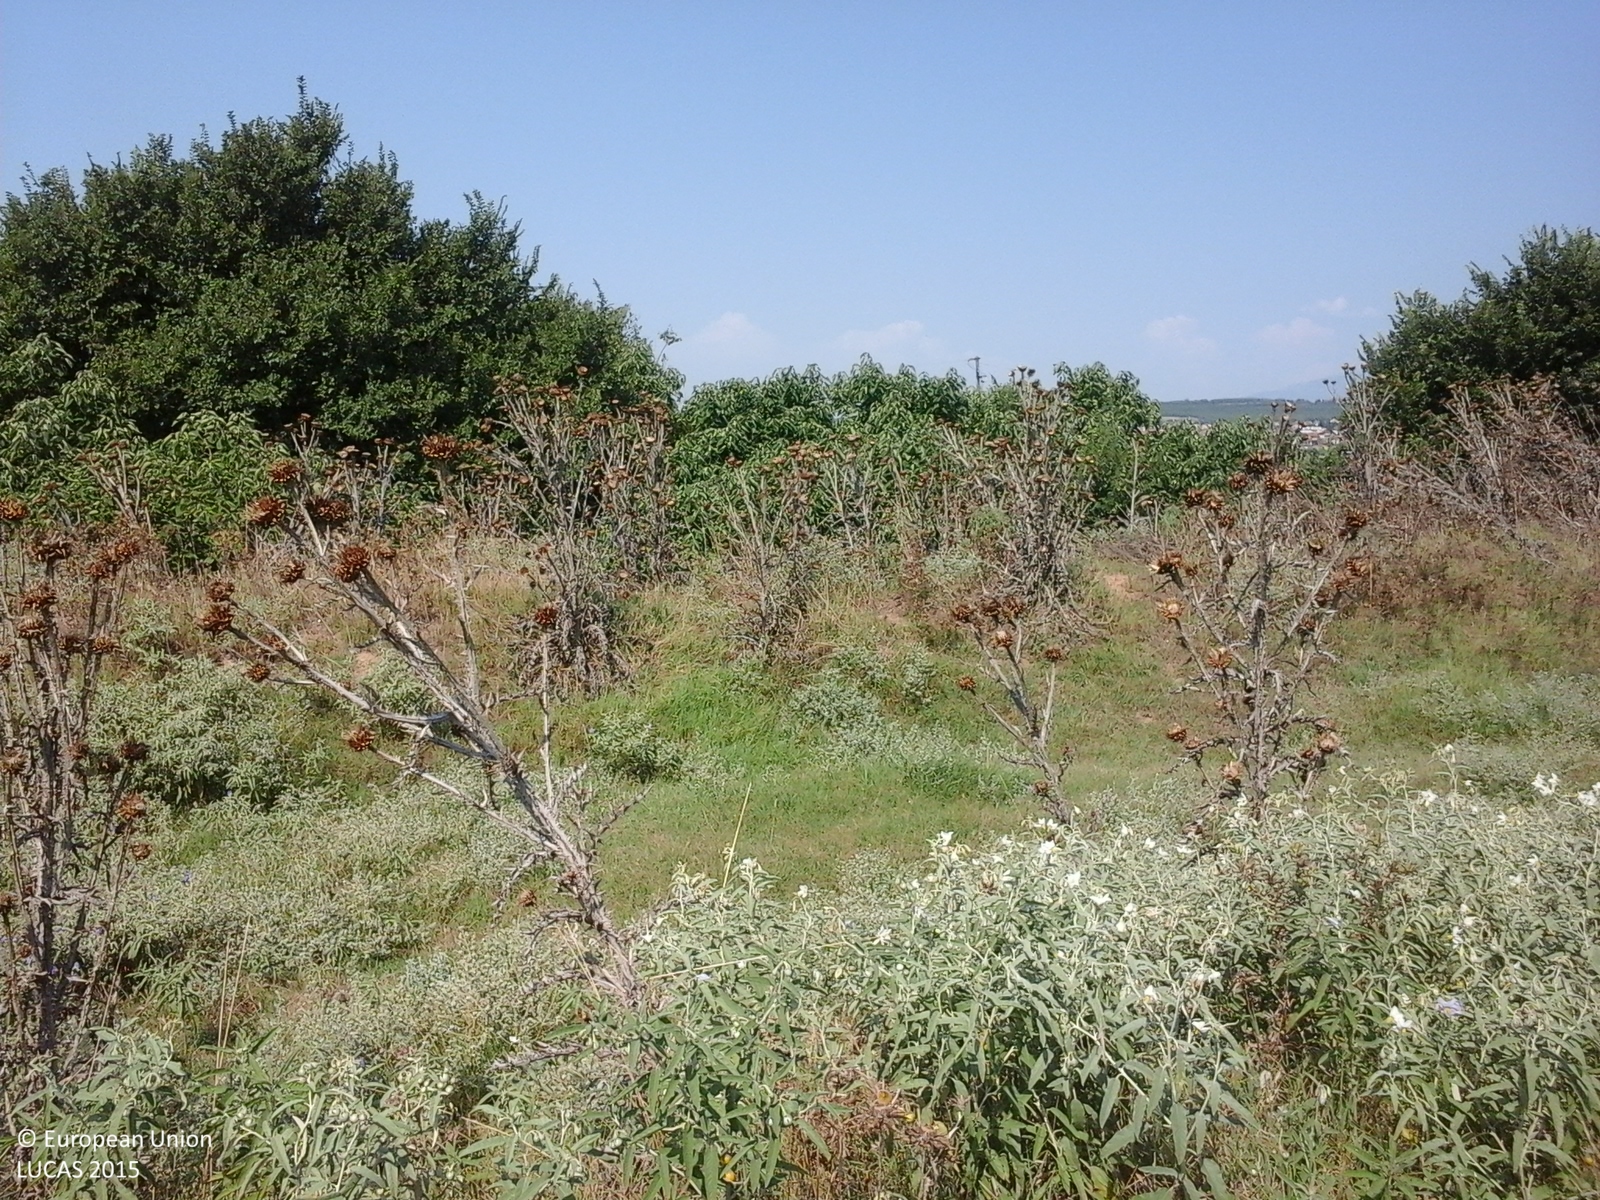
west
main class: Artificial land
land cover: Non built-up linear features
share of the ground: > 75 %
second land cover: Spontaneously vegetated surfaces
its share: > 75 %
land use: Road transport
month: August
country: GR
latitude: 40.7681
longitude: 22.5982
